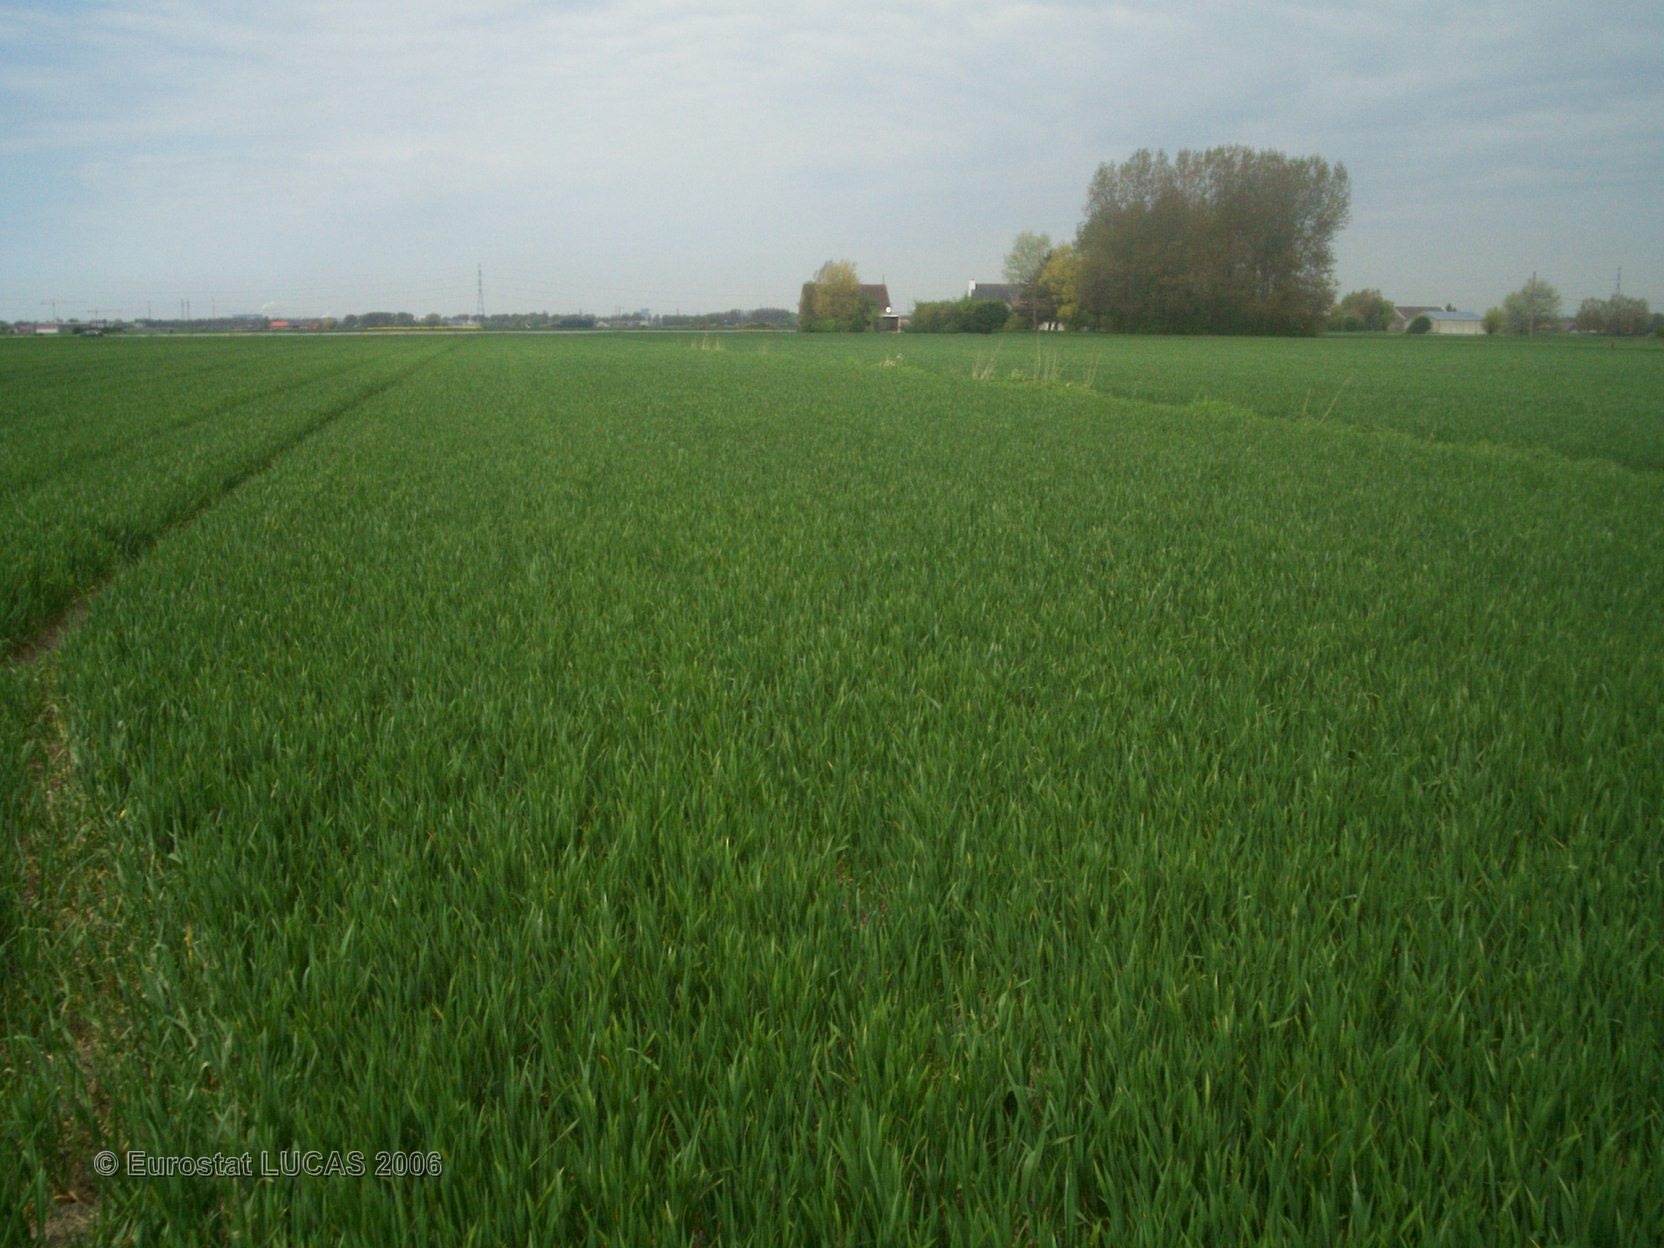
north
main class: Cropland
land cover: Common wheat
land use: Agriculture (excluding fallow land and kitchen gardens)
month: May
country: FR
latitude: 50.9739
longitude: 2.3385
